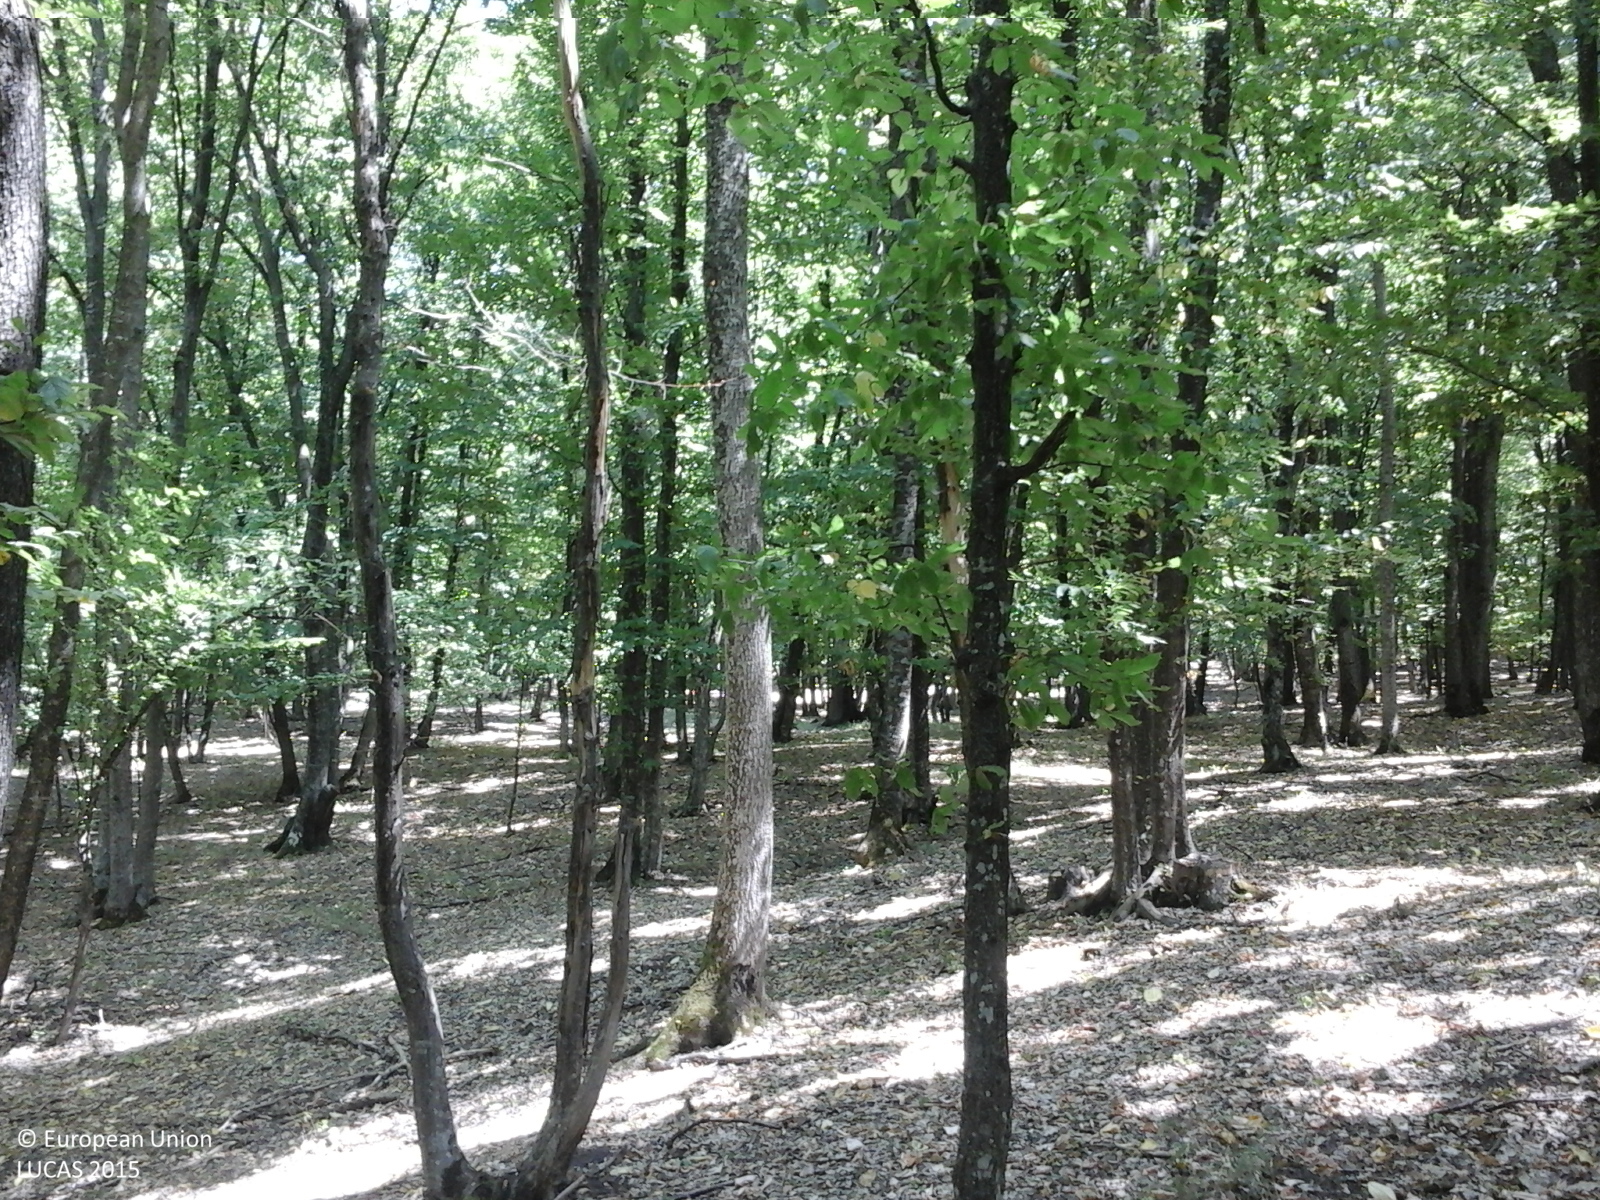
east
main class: Woodland
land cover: Broadleaved woodland
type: beech forest
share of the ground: > 75 %
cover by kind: broadleaved forest trees 100 %
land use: Forestry
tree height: > 5 m
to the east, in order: Broadleaved woodland
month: July
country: RO
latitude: 46.2802
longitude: 27.2454
